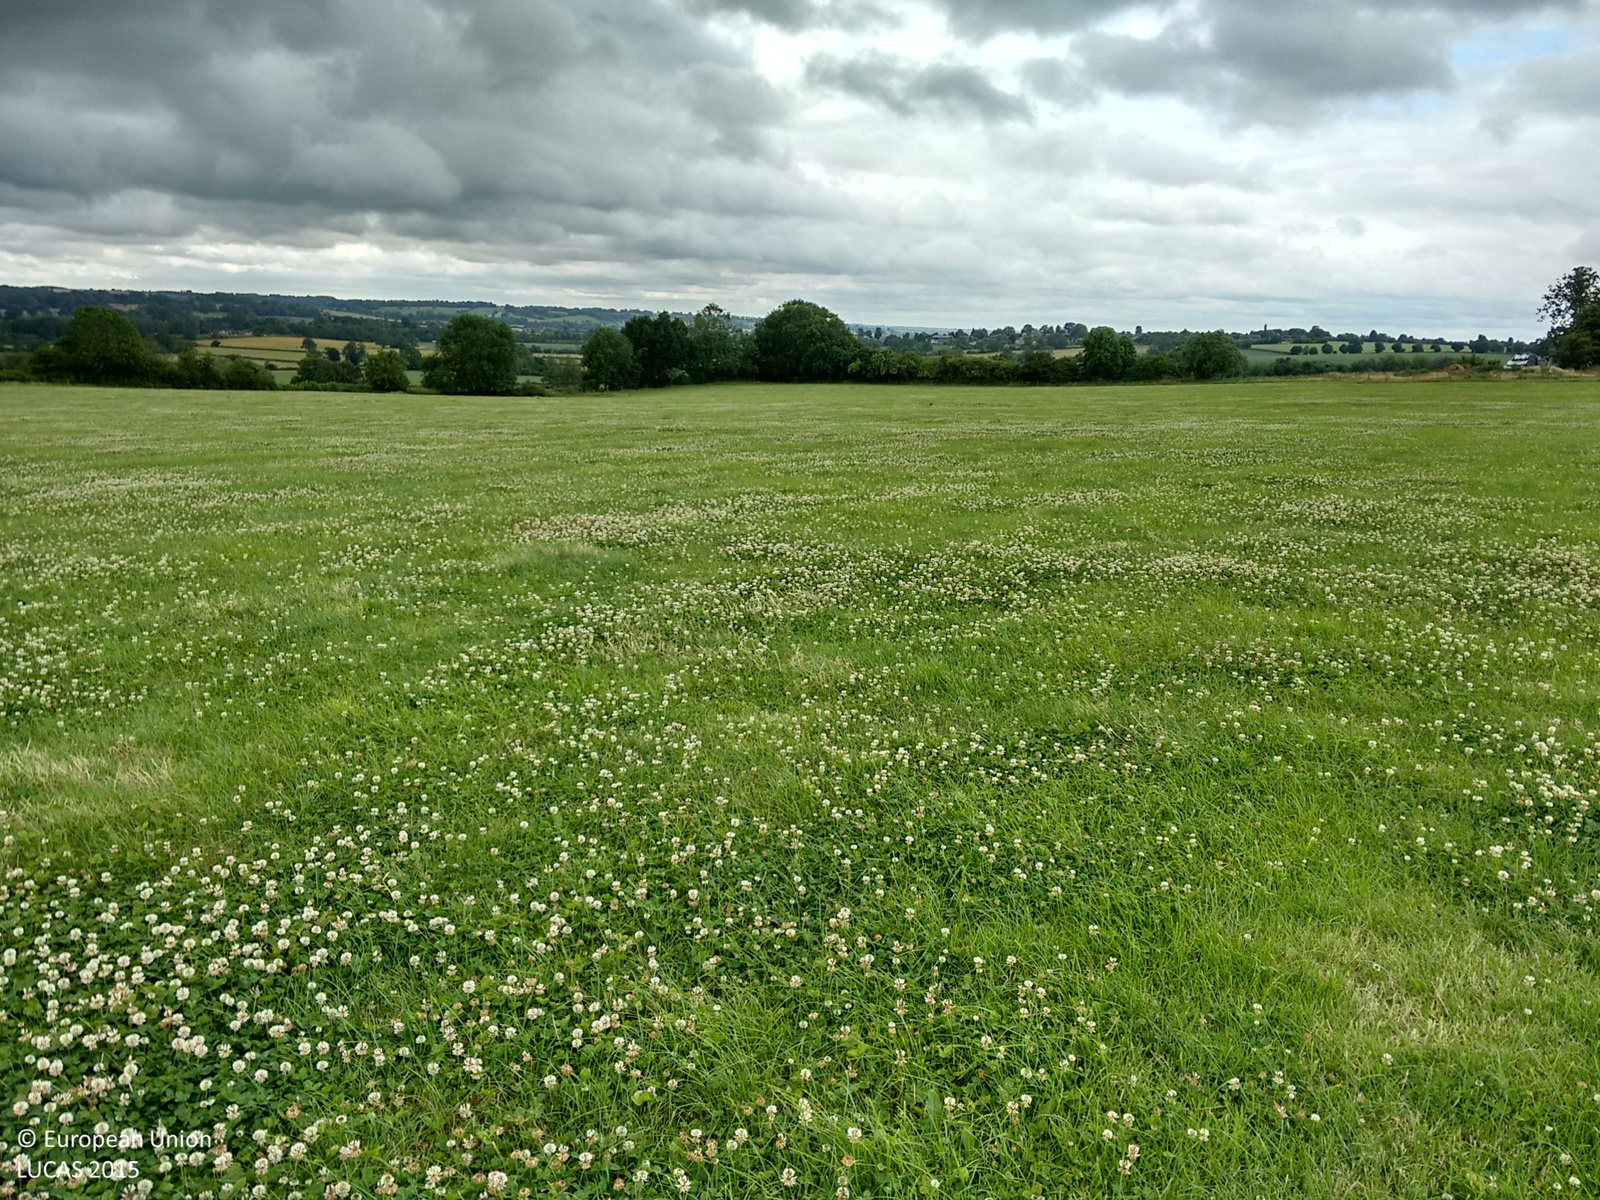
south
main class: Grassland
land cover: Grassland without tree/shrub cover
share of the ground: > 75 %
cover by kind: herbaceous plants 100 %
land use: Agriculture (excluding fallow land and kitchen gardens)
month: July
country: GB
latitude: 52.1227
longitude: -1.3392
